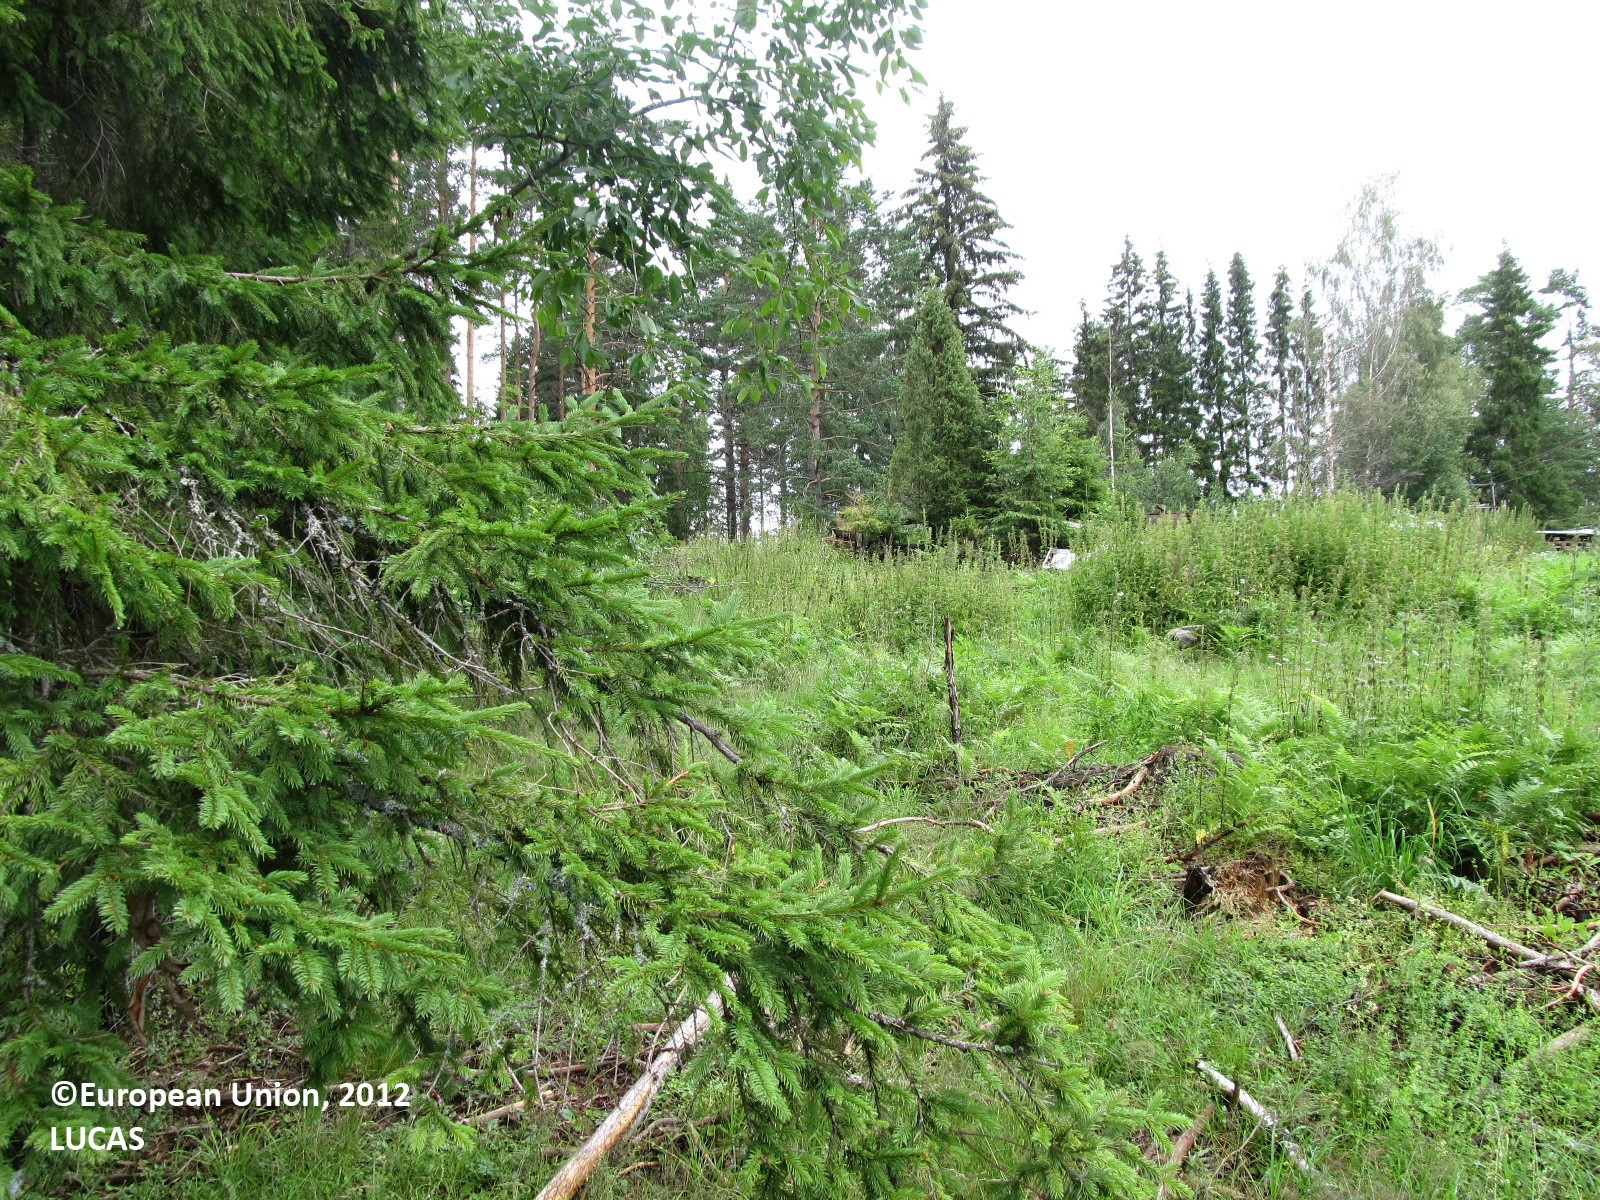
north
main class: Grassland
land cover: Grassland without tree/shrub cover
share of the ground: 25 - 50 %
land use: Forestry
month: July
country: FI
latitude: 61.8472
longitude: 29.0175
